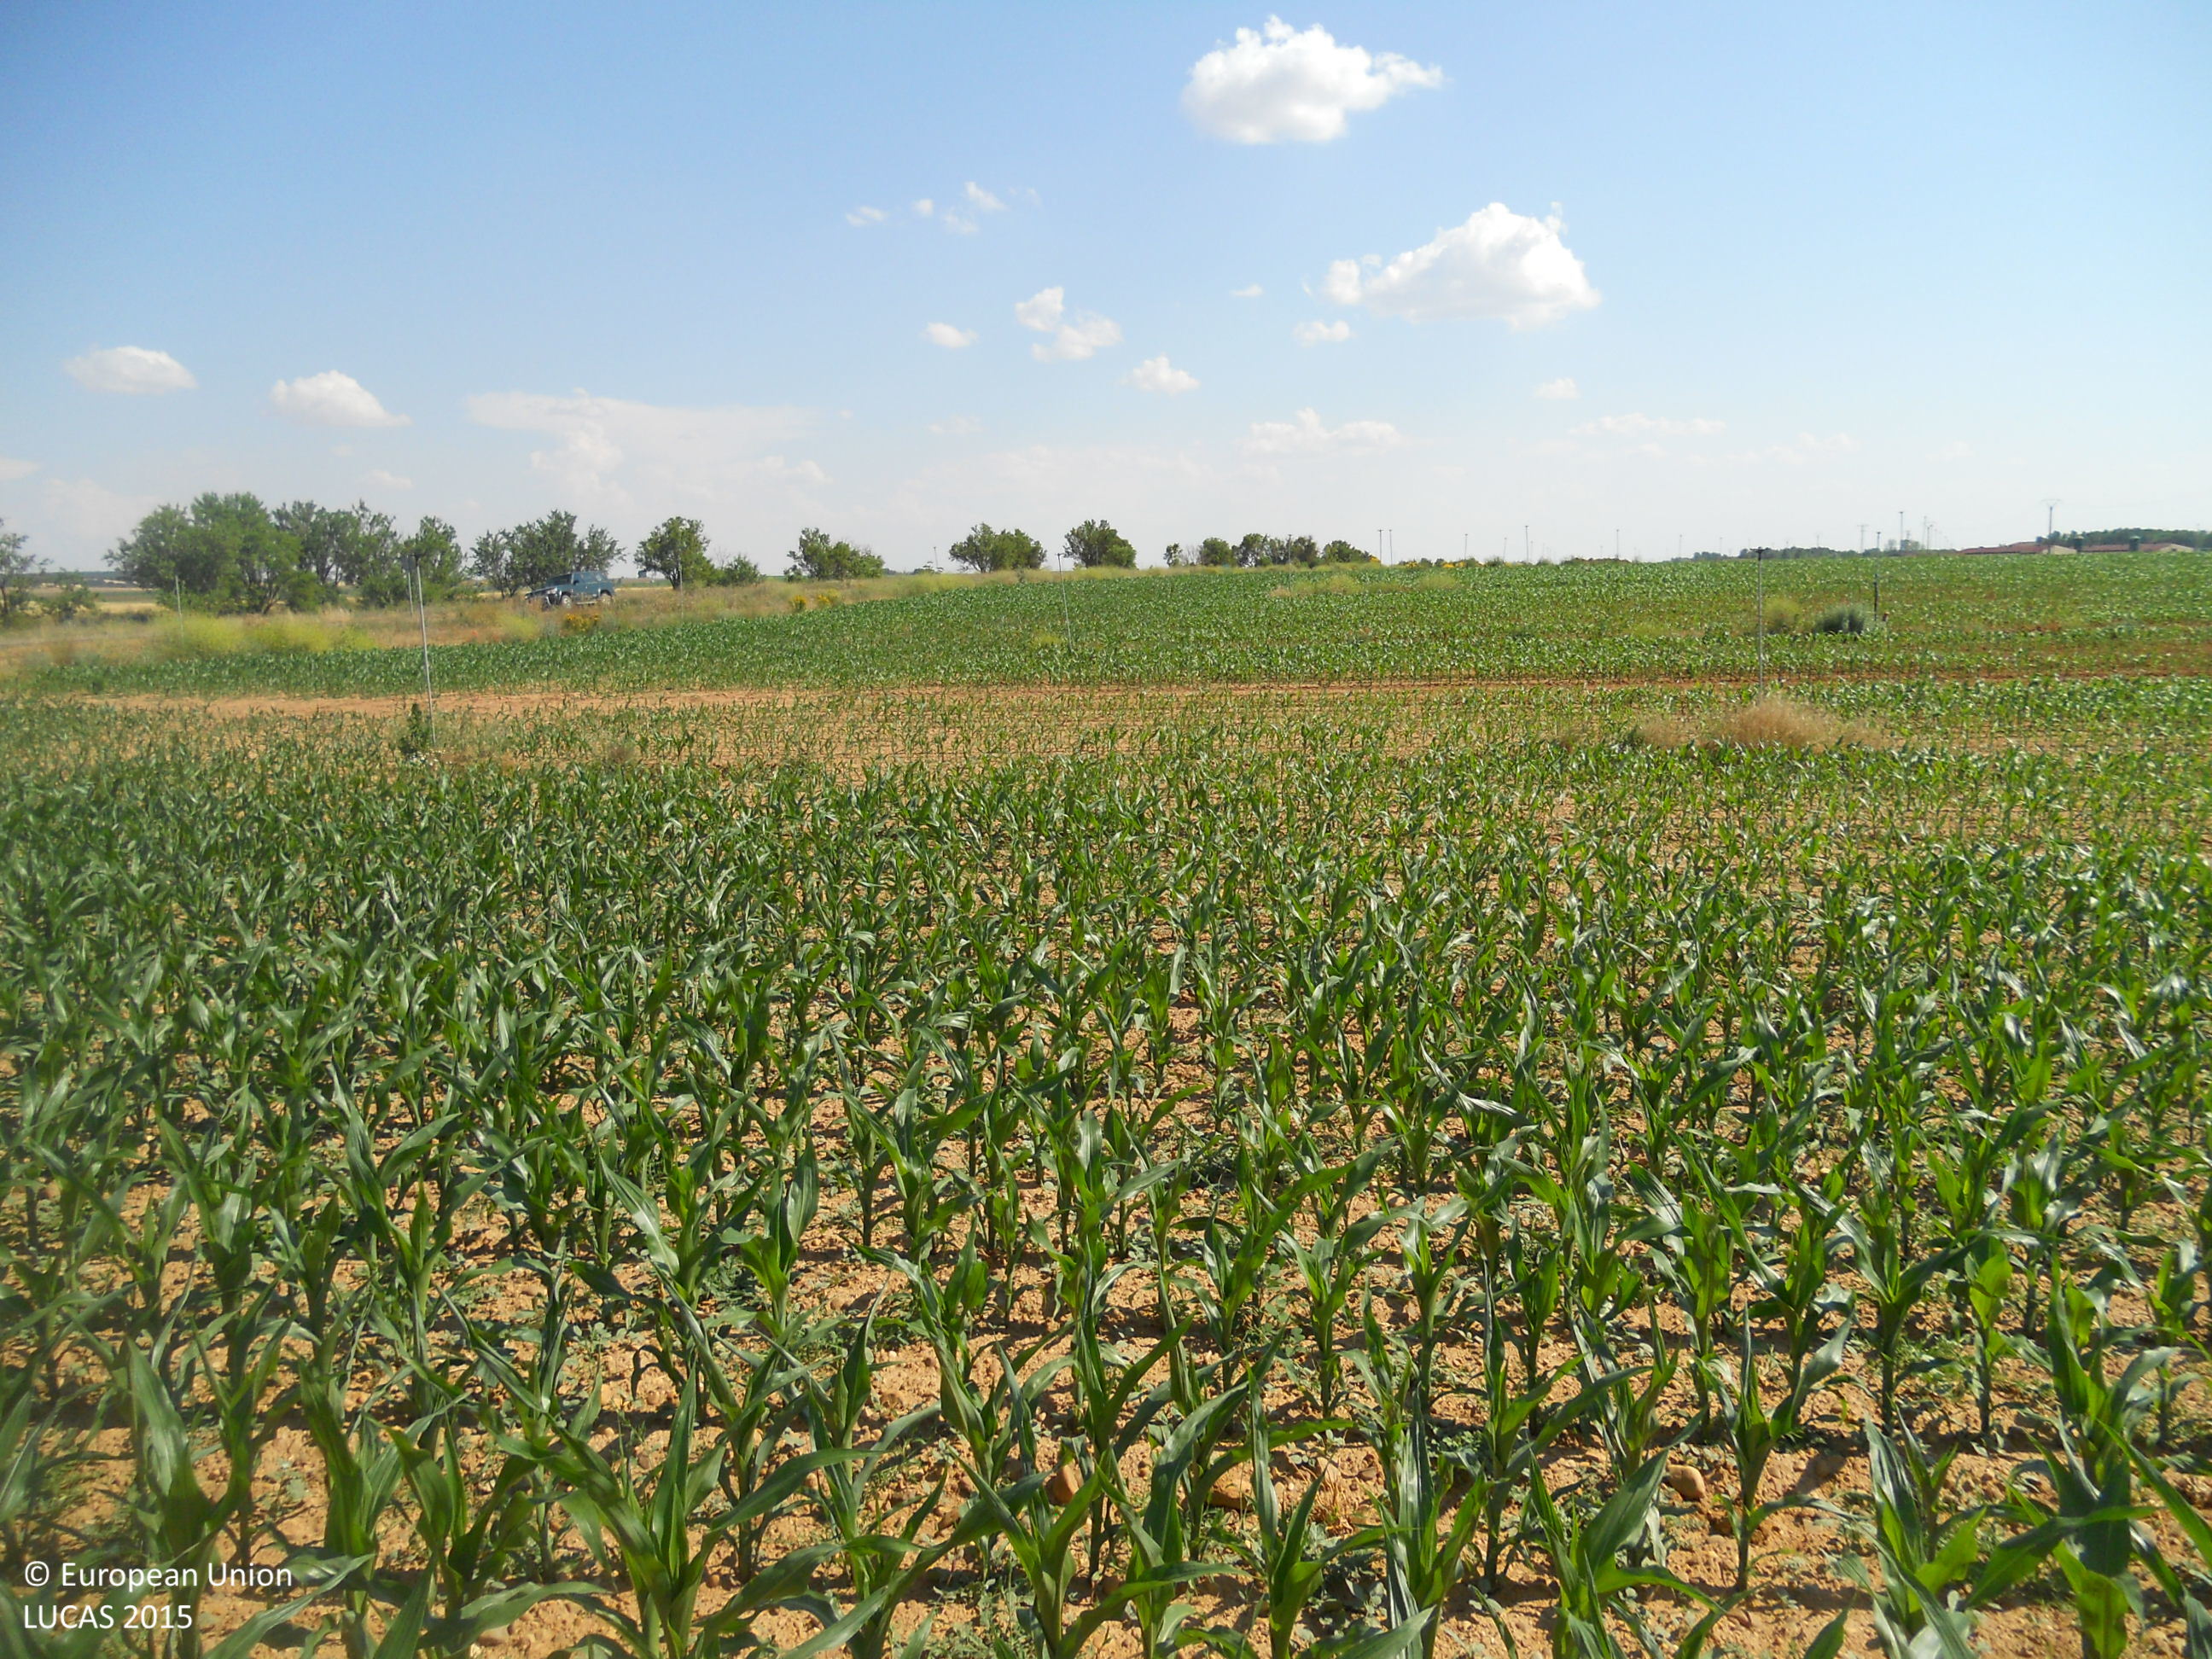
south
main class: Cropland
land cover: Maize
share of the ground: 10 - 25 %
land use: Agriculture (excluding fallow land and kitchen gardens)
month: June
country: ES
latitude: 42.2565
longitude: -5.5227
